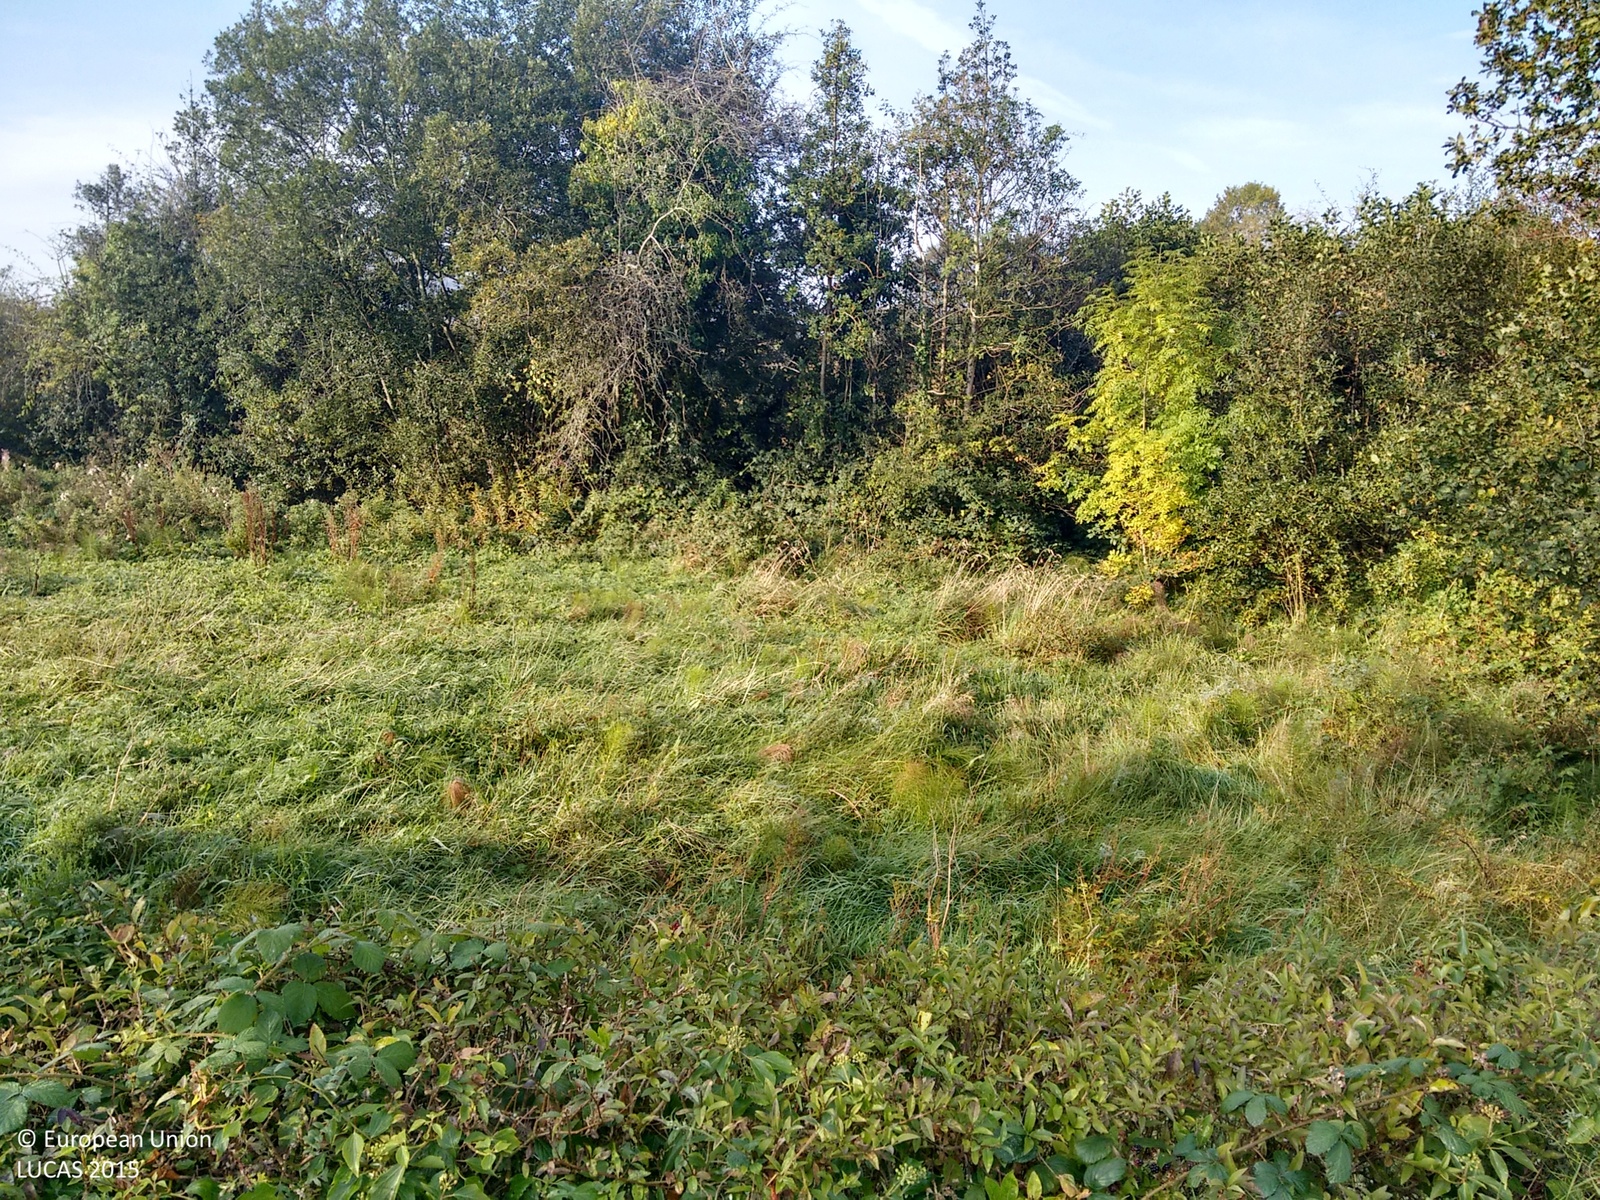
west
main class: Grassland
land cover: Grassland without tree/shrub cover
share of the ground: > 75 %
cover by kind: herbaceous plants 100 %
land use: Residential
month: October
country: GB
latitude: 54.2401
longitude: -7.7016
